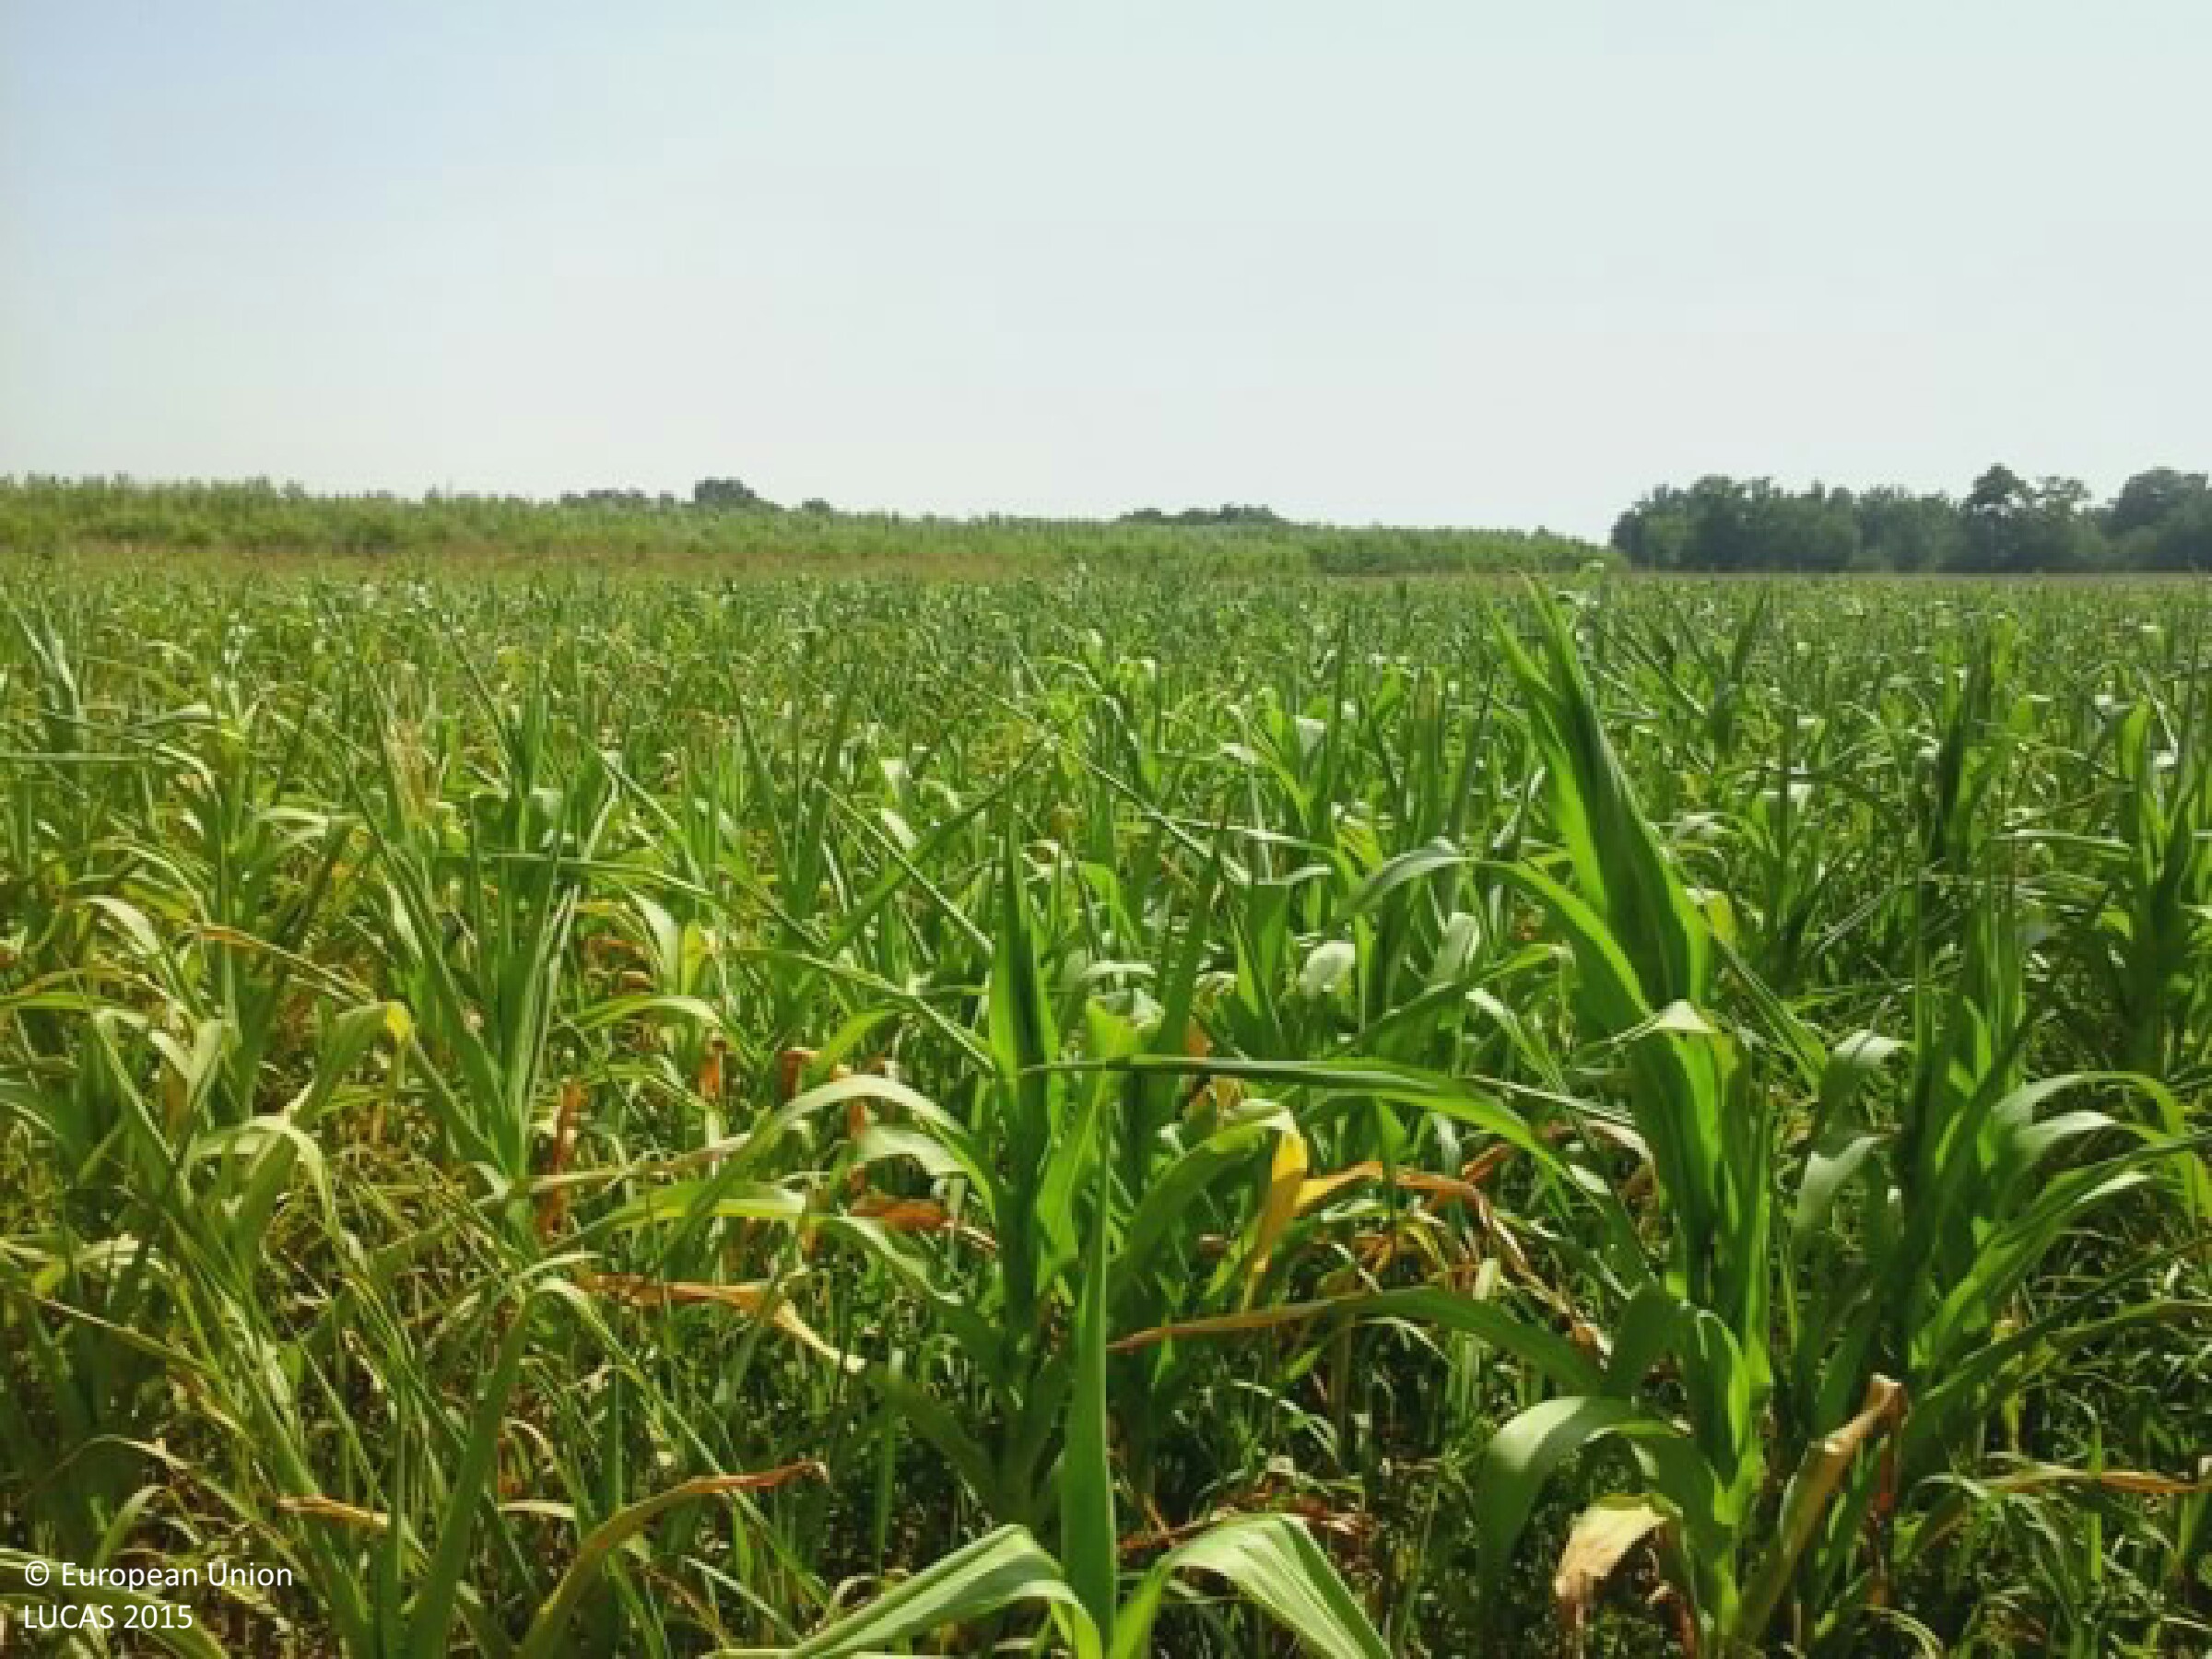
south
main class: Cropland
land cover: Maize
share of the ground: 50 - 75 %
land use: Agriculture (excluding fallow land and kitchen gardens)
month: July
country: HU
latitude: 47.2315
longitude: 19.0912
